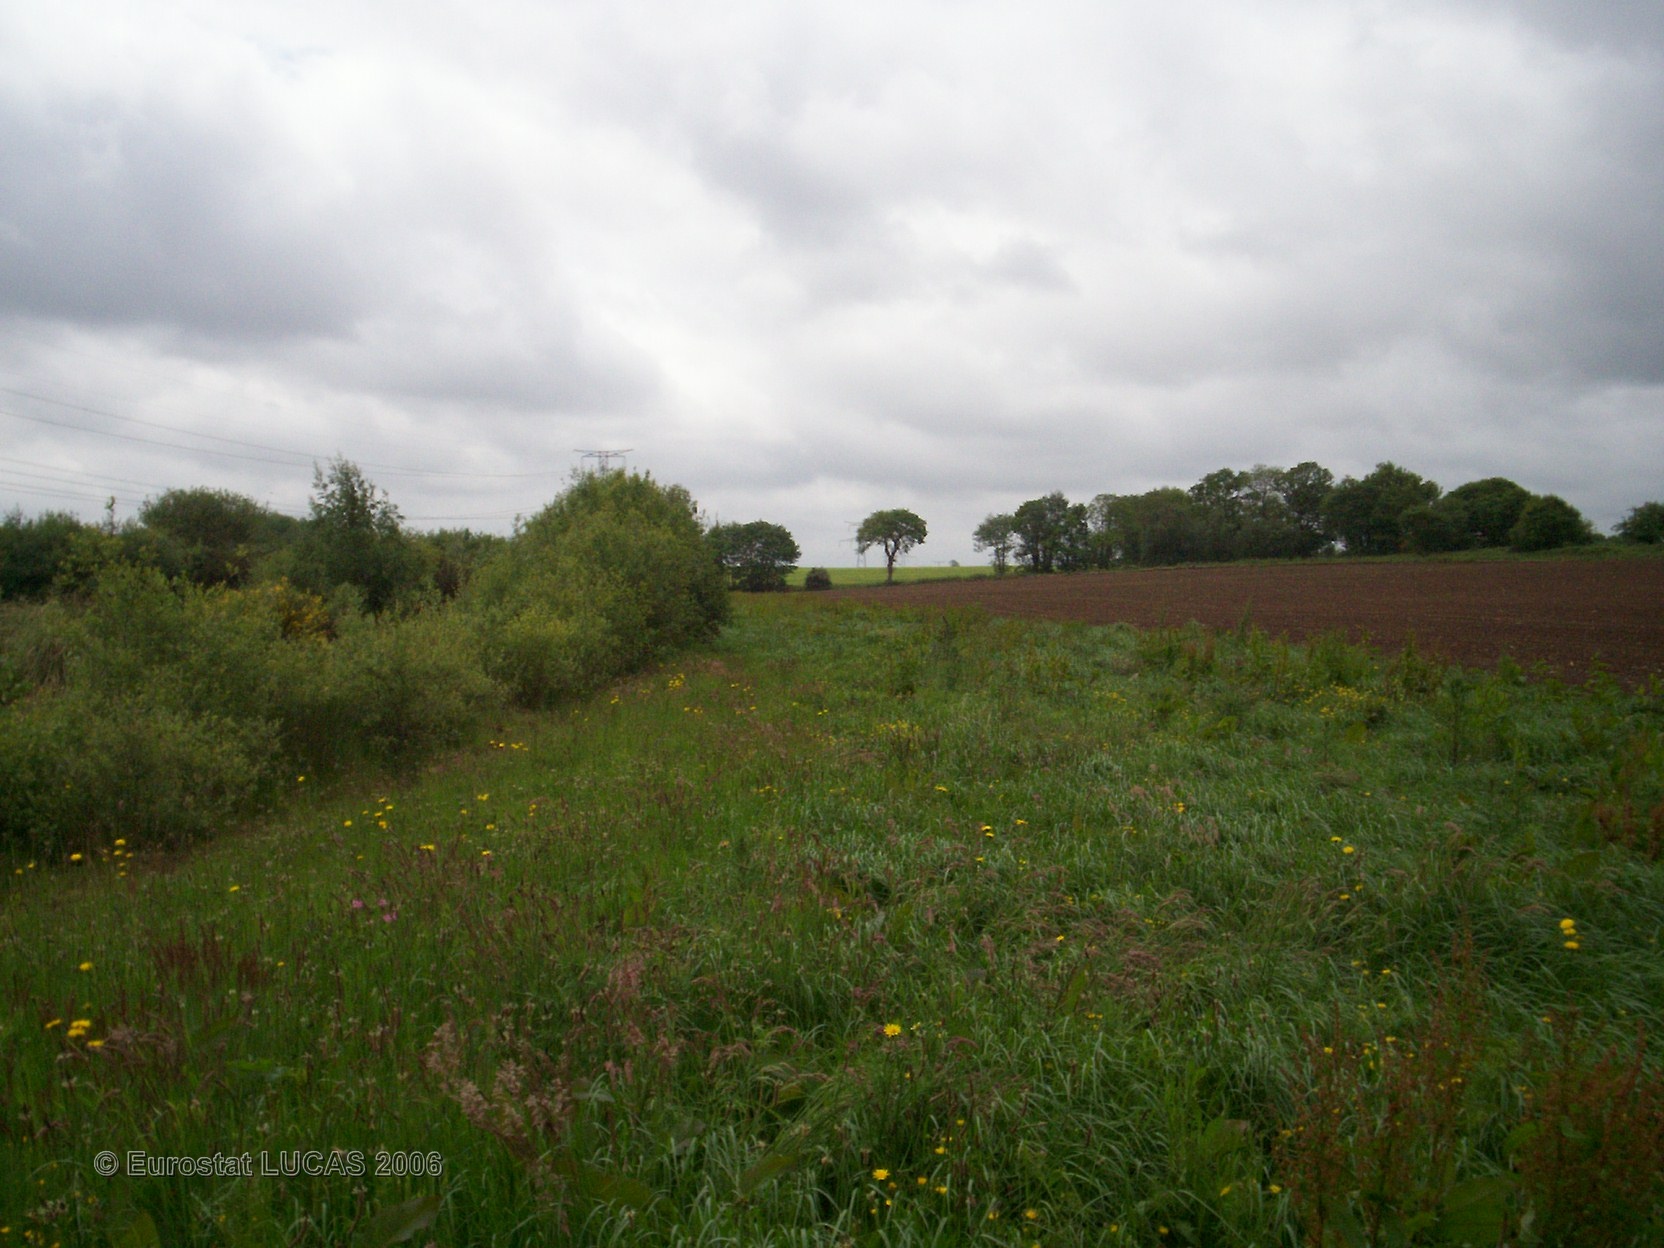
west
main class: Grassland
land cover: Grassland without tree/shrub cover
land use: Fallow land
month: May
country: FR
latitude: 47.9465
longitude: -3.5599
